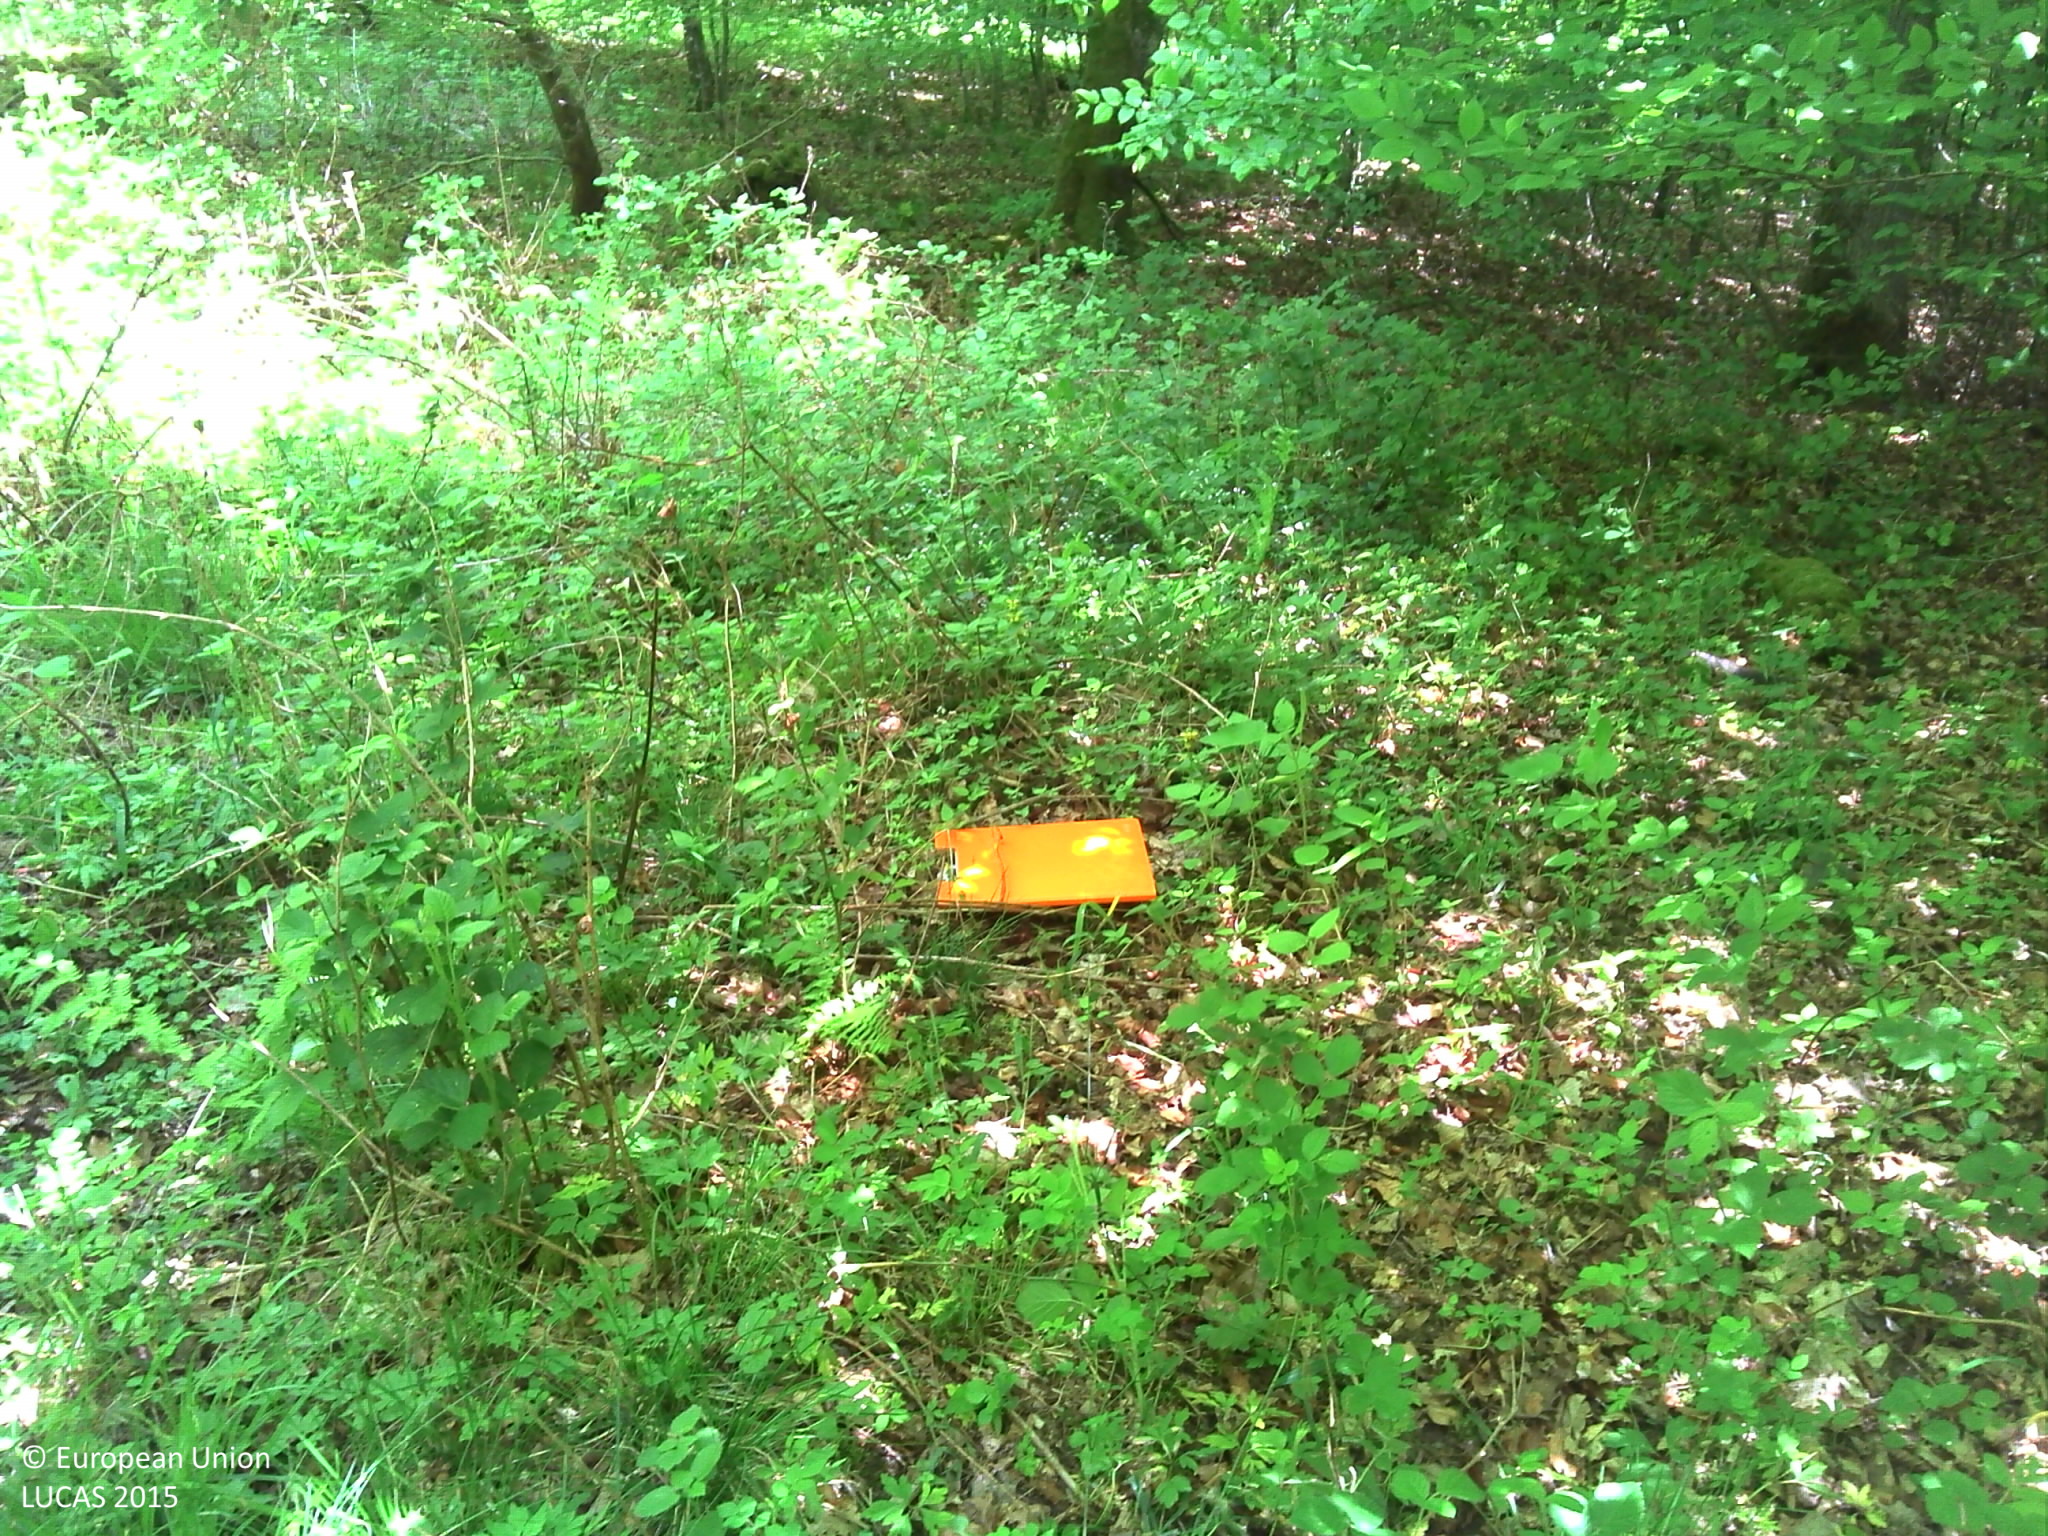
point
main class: Woodland
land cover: Broadleaved woodland
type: acidophilous oak and oak-birch forest
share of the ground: > 75 %
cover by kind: broadleaved forest trees 80 %, herbaceous plants 10 %, lichens and mosses 10 %
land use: Forestry
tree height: > 5 m
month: May
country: LU
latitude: 49.6912
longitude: 6.2706
